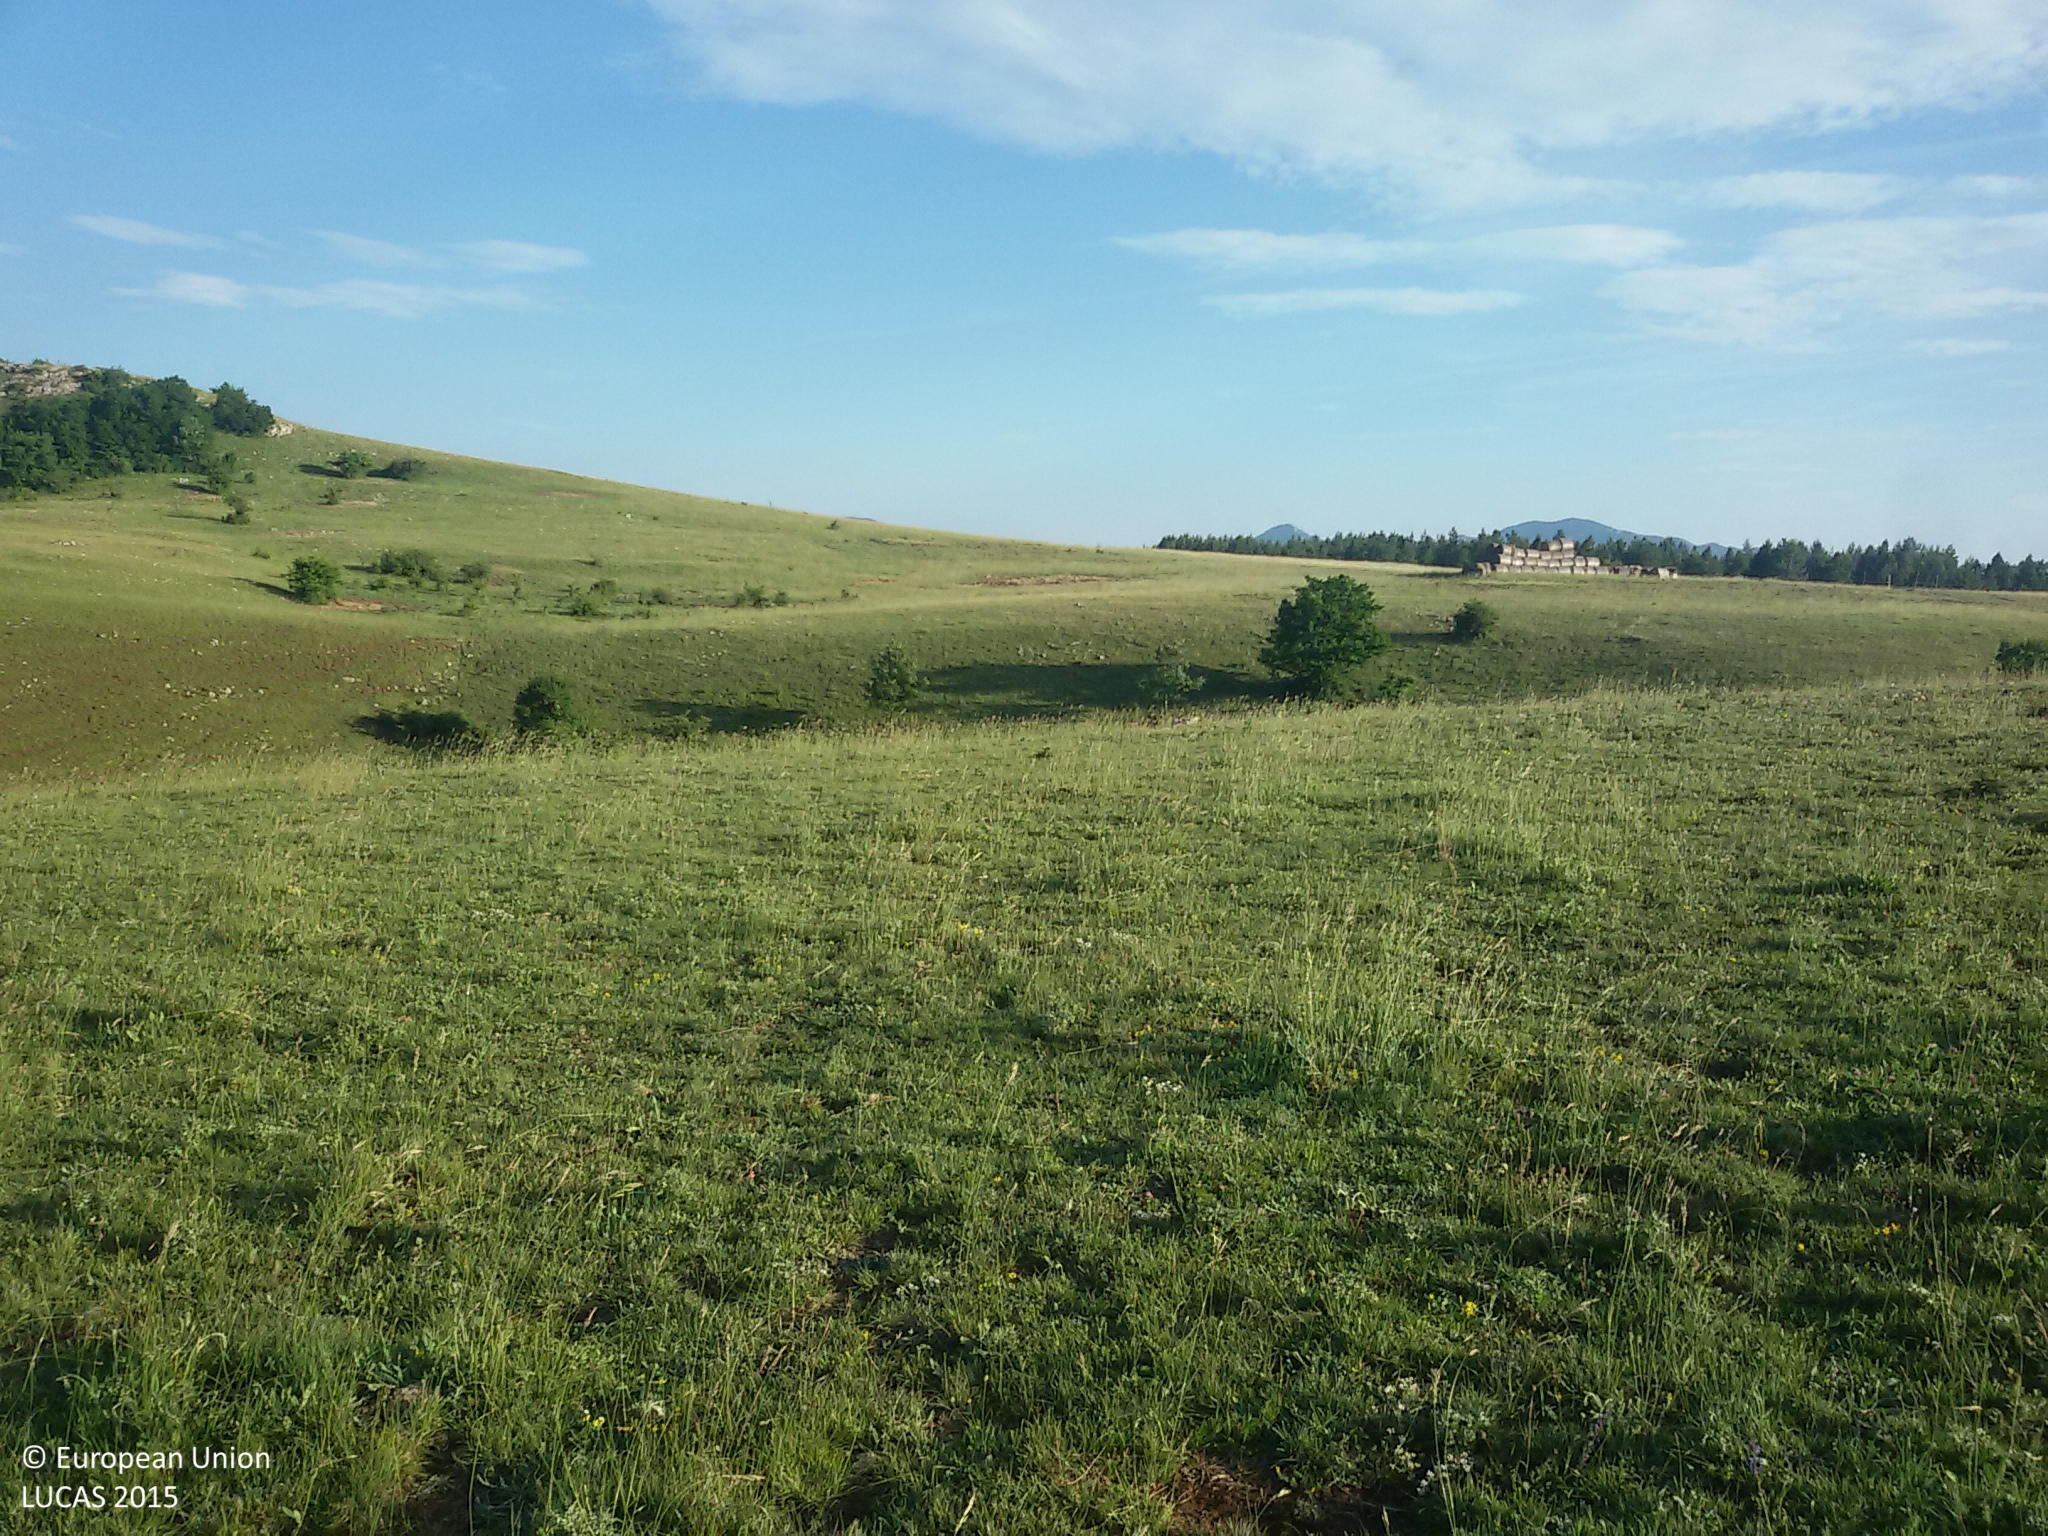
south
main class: Grassland
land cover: Grassland without tree/shrub cover
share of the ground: > 75 %
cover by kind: herbaceous plants 95 %, unconsolidated bare surface 5 %
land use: Agriculture (excluding fallow land and kitchen gardens)
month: June
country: HR
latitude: 44.5349
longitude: 15.7448
